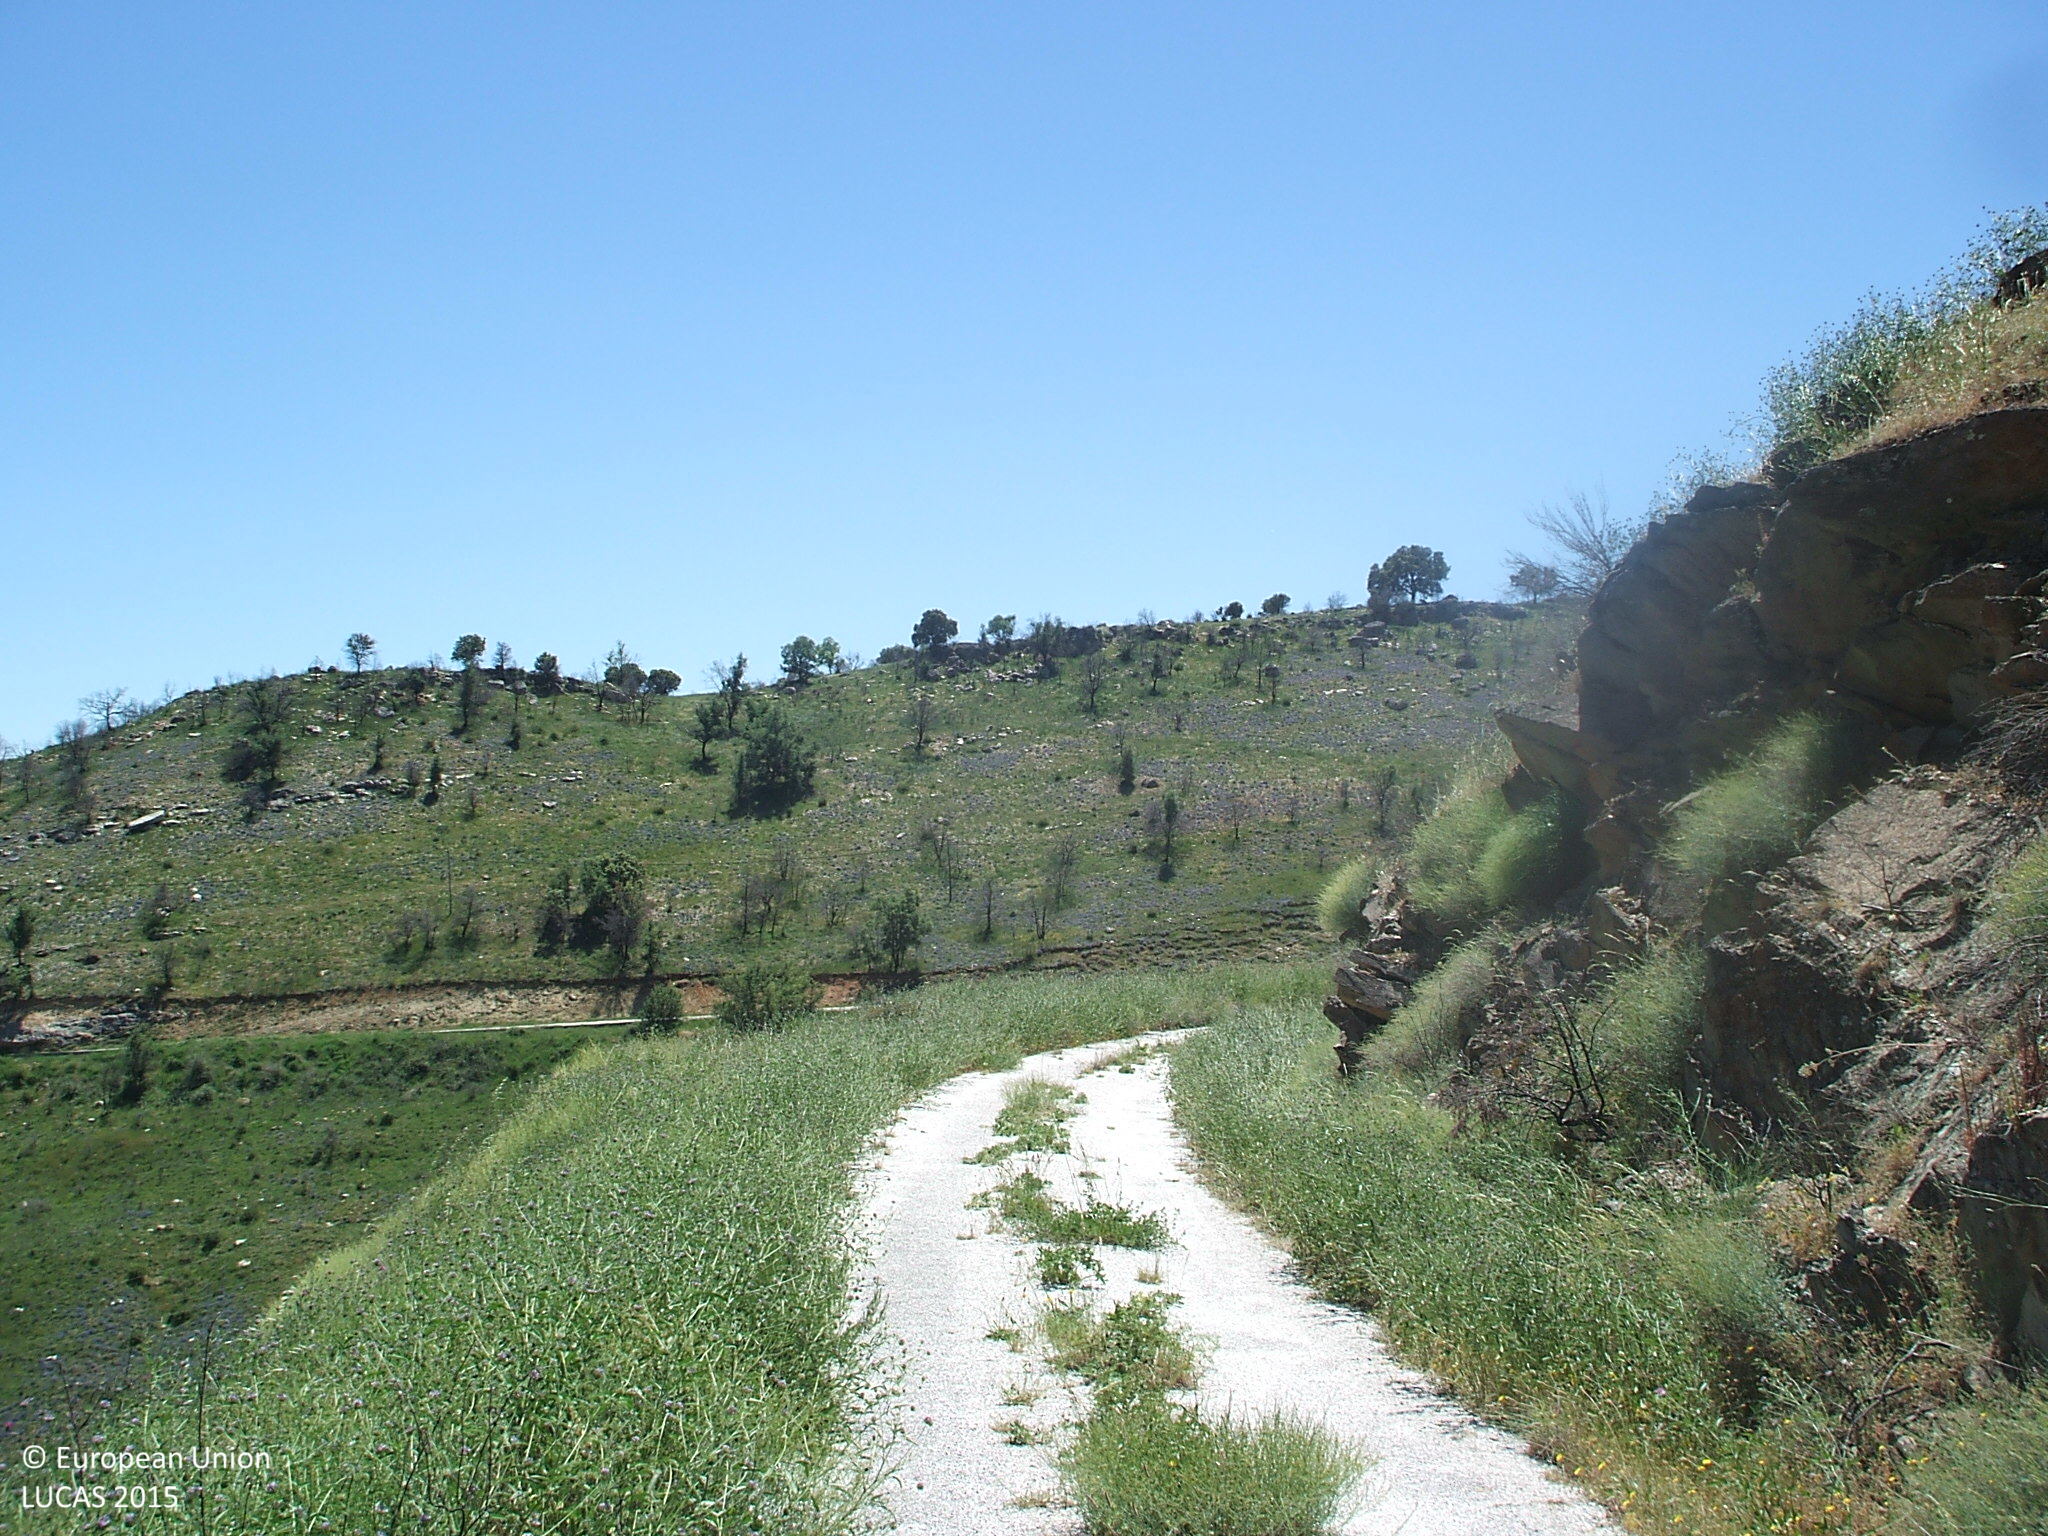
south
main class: Shrubland
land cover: Shrubland without tree cover
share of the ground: 10 - 25 %
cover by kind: consolidated bare surface 70 %, shrubs 15 %, herbaceous plants 15 %
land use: Semi-natural and natural areas not in use
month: May
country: ES
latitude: 40.9245
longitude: -3.3511
